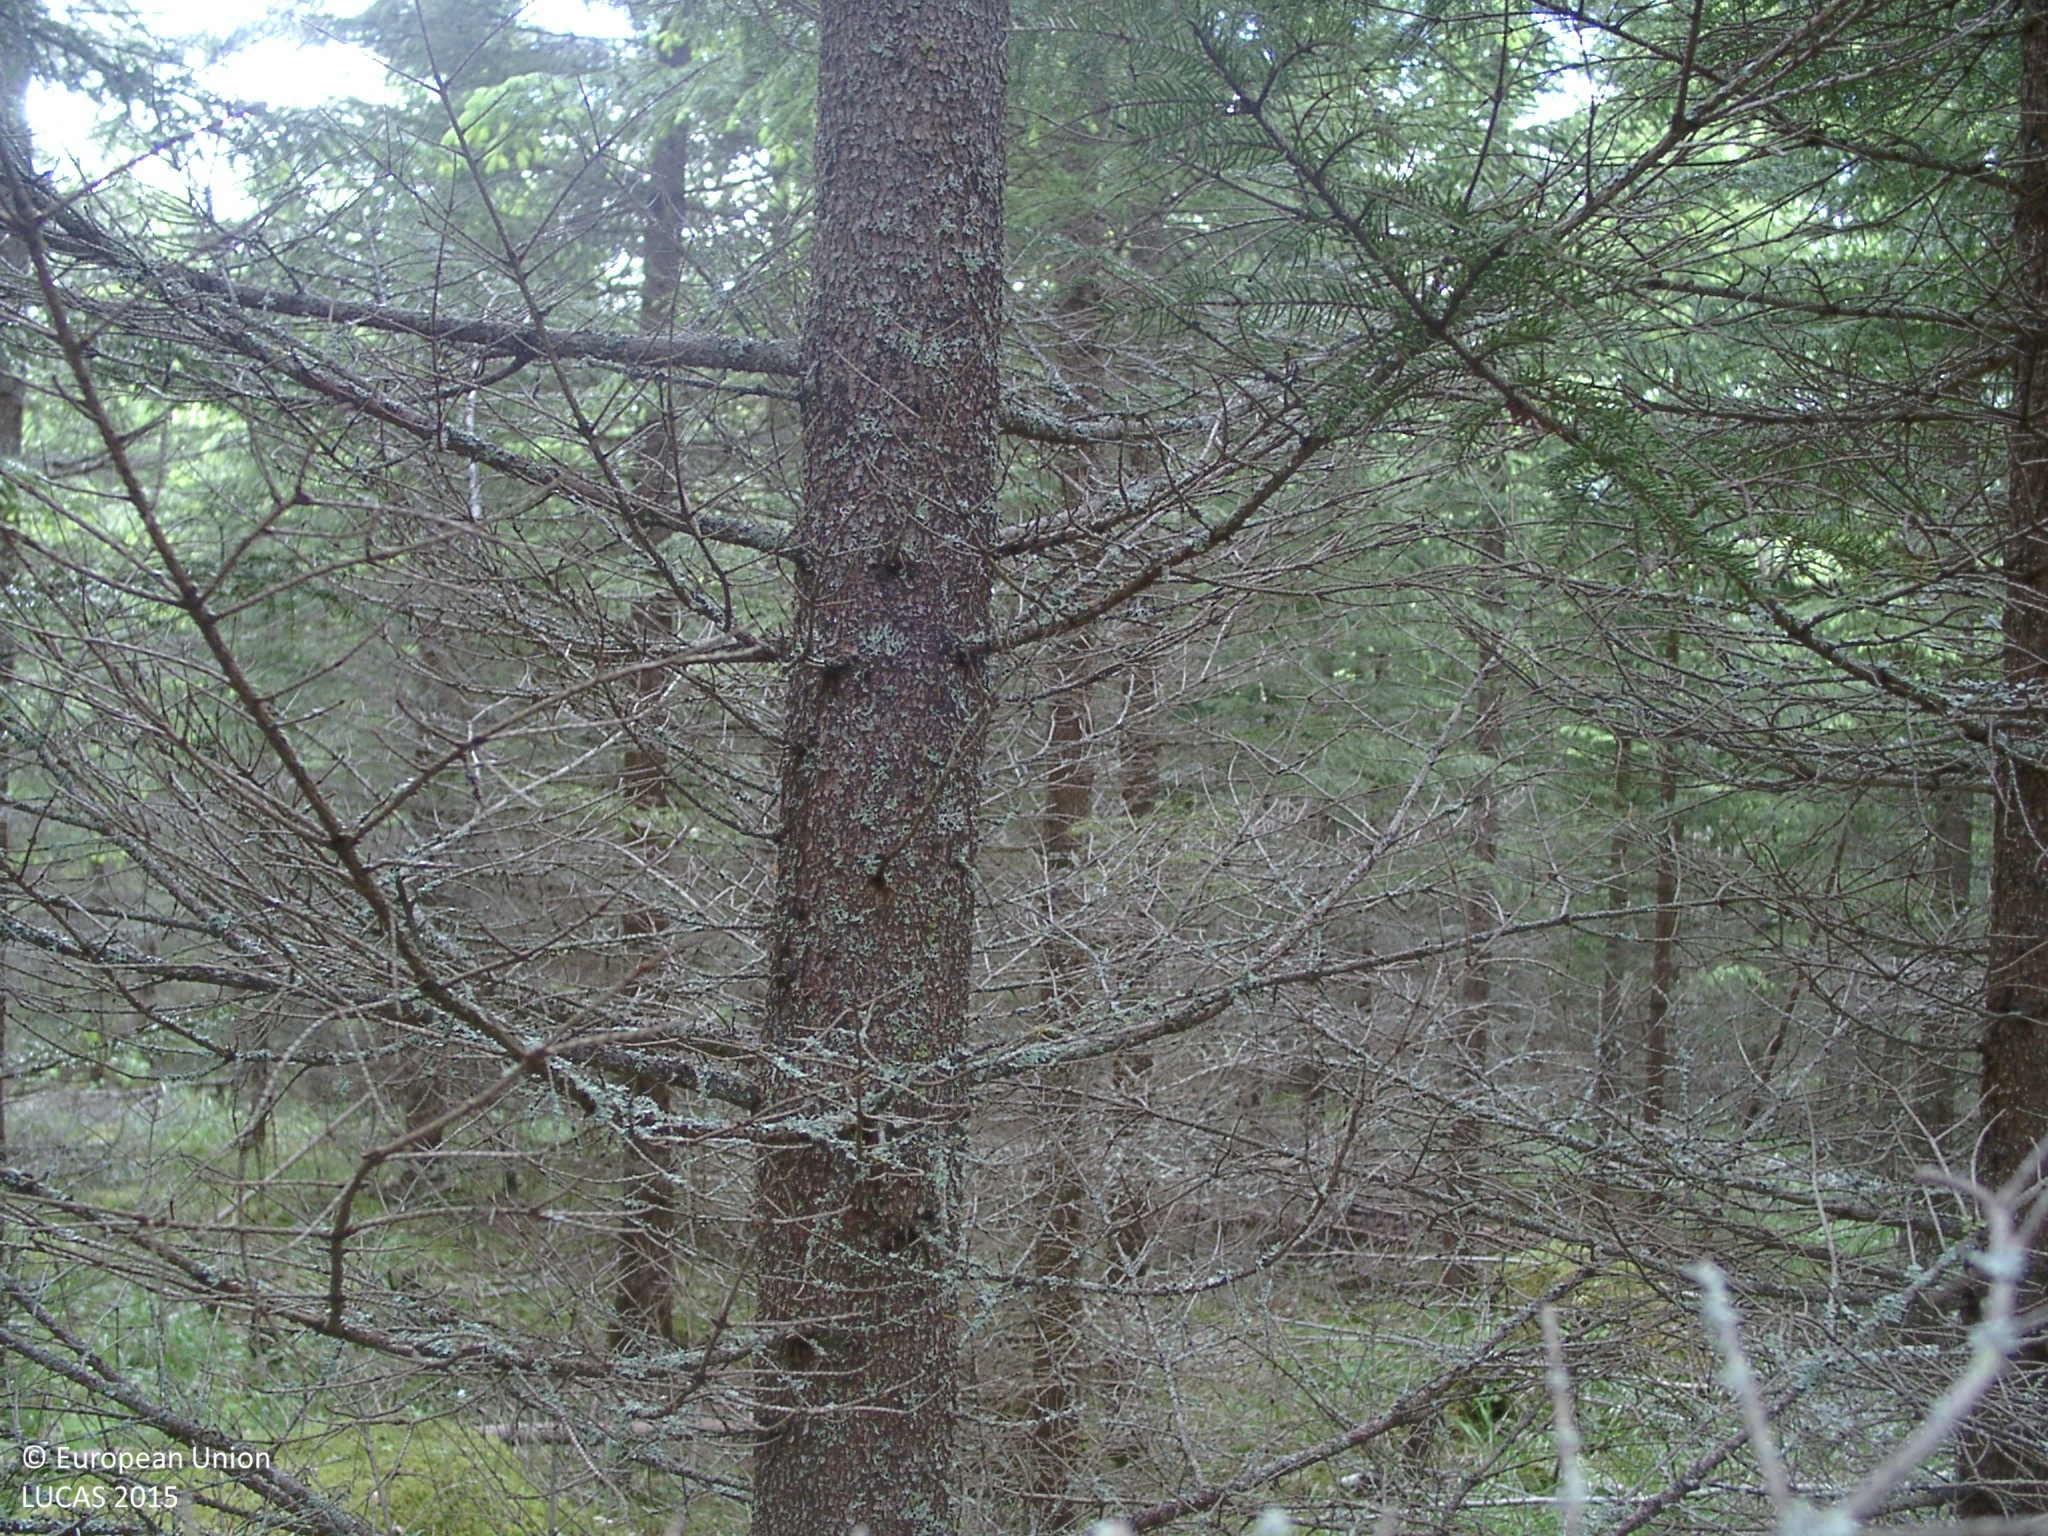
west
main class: Woodland
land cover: Spruce dominated coniferous woodland
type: boreal forest
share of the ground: 50 - 75 %
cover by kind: coniferous forest trees 70 %, herbaceous plants 20 %, lichens and mosses 10 %
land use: Forestry
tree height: > 5 m
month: June
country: FI
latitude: 61.7722
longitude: 24.9068
